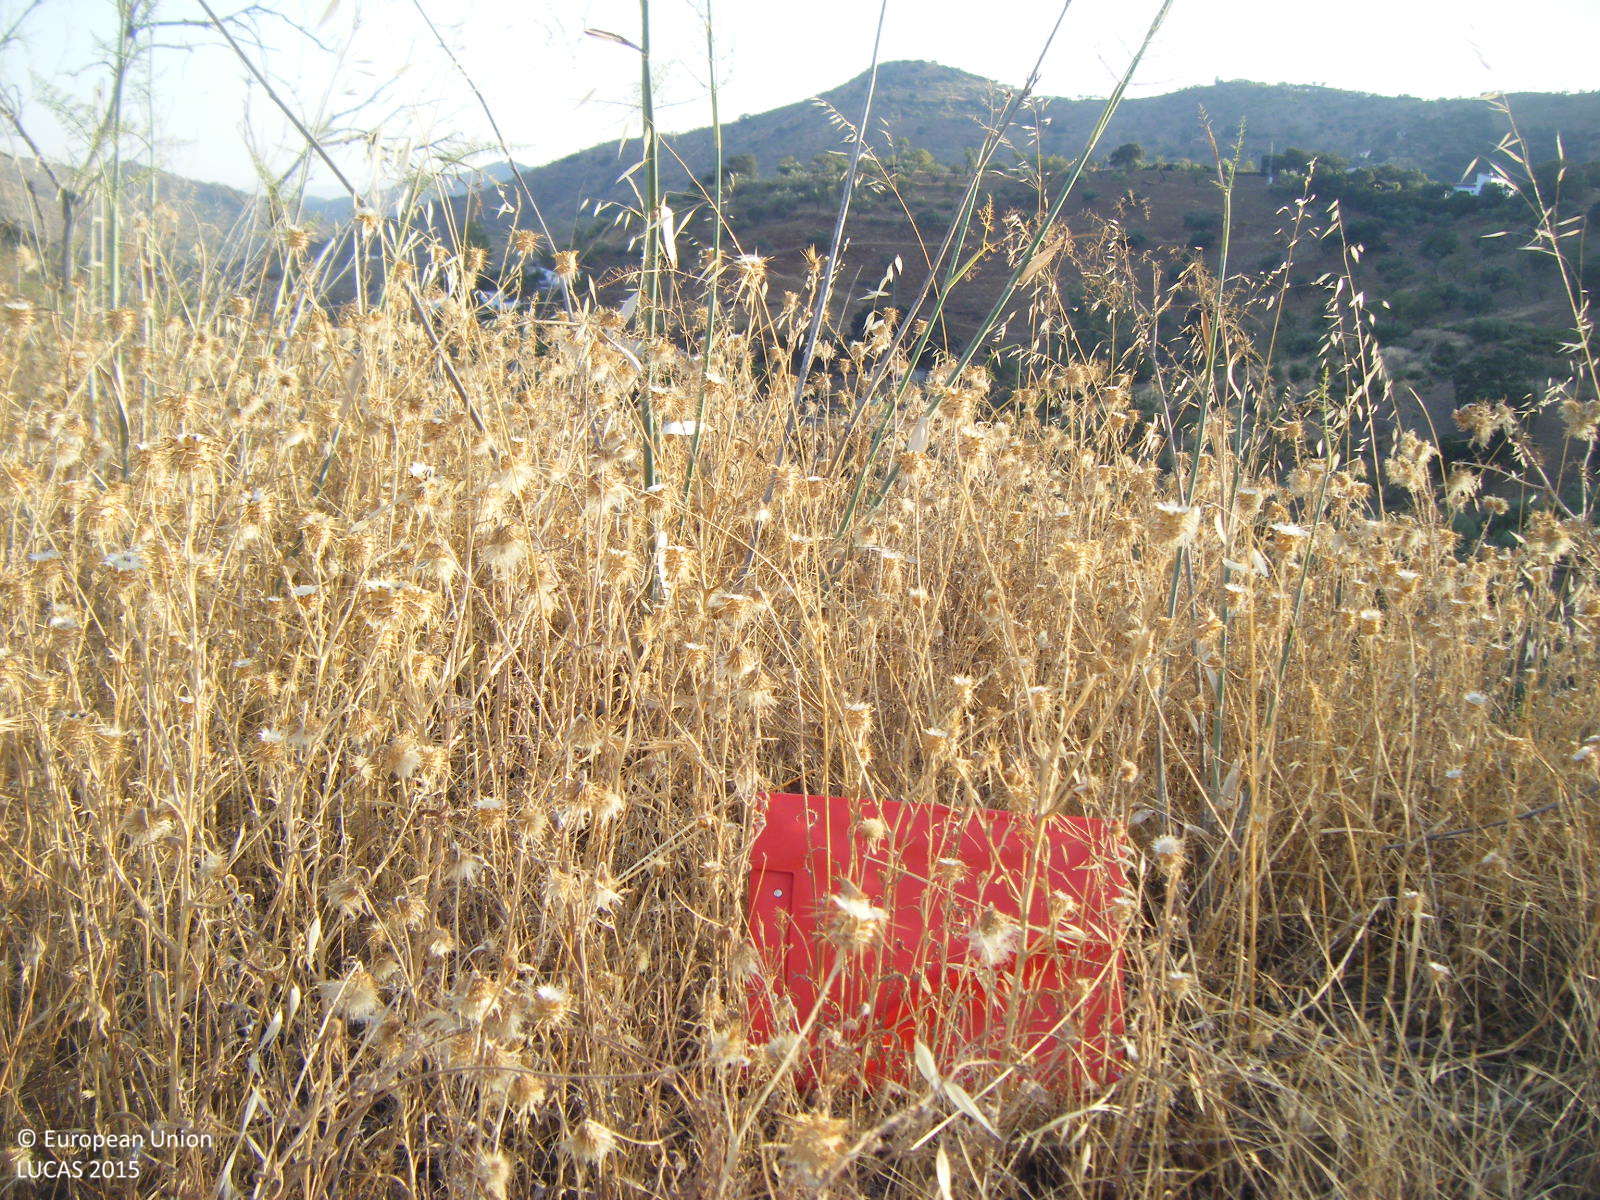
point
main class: Grassland
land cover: Grassland without tree/shrub cover
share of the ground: > 75 %
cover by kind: herbaceous plants 100 %
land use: Semi-natural and natural areas not in use
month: July
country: ES
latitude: 36.8794
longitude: -4.4321
